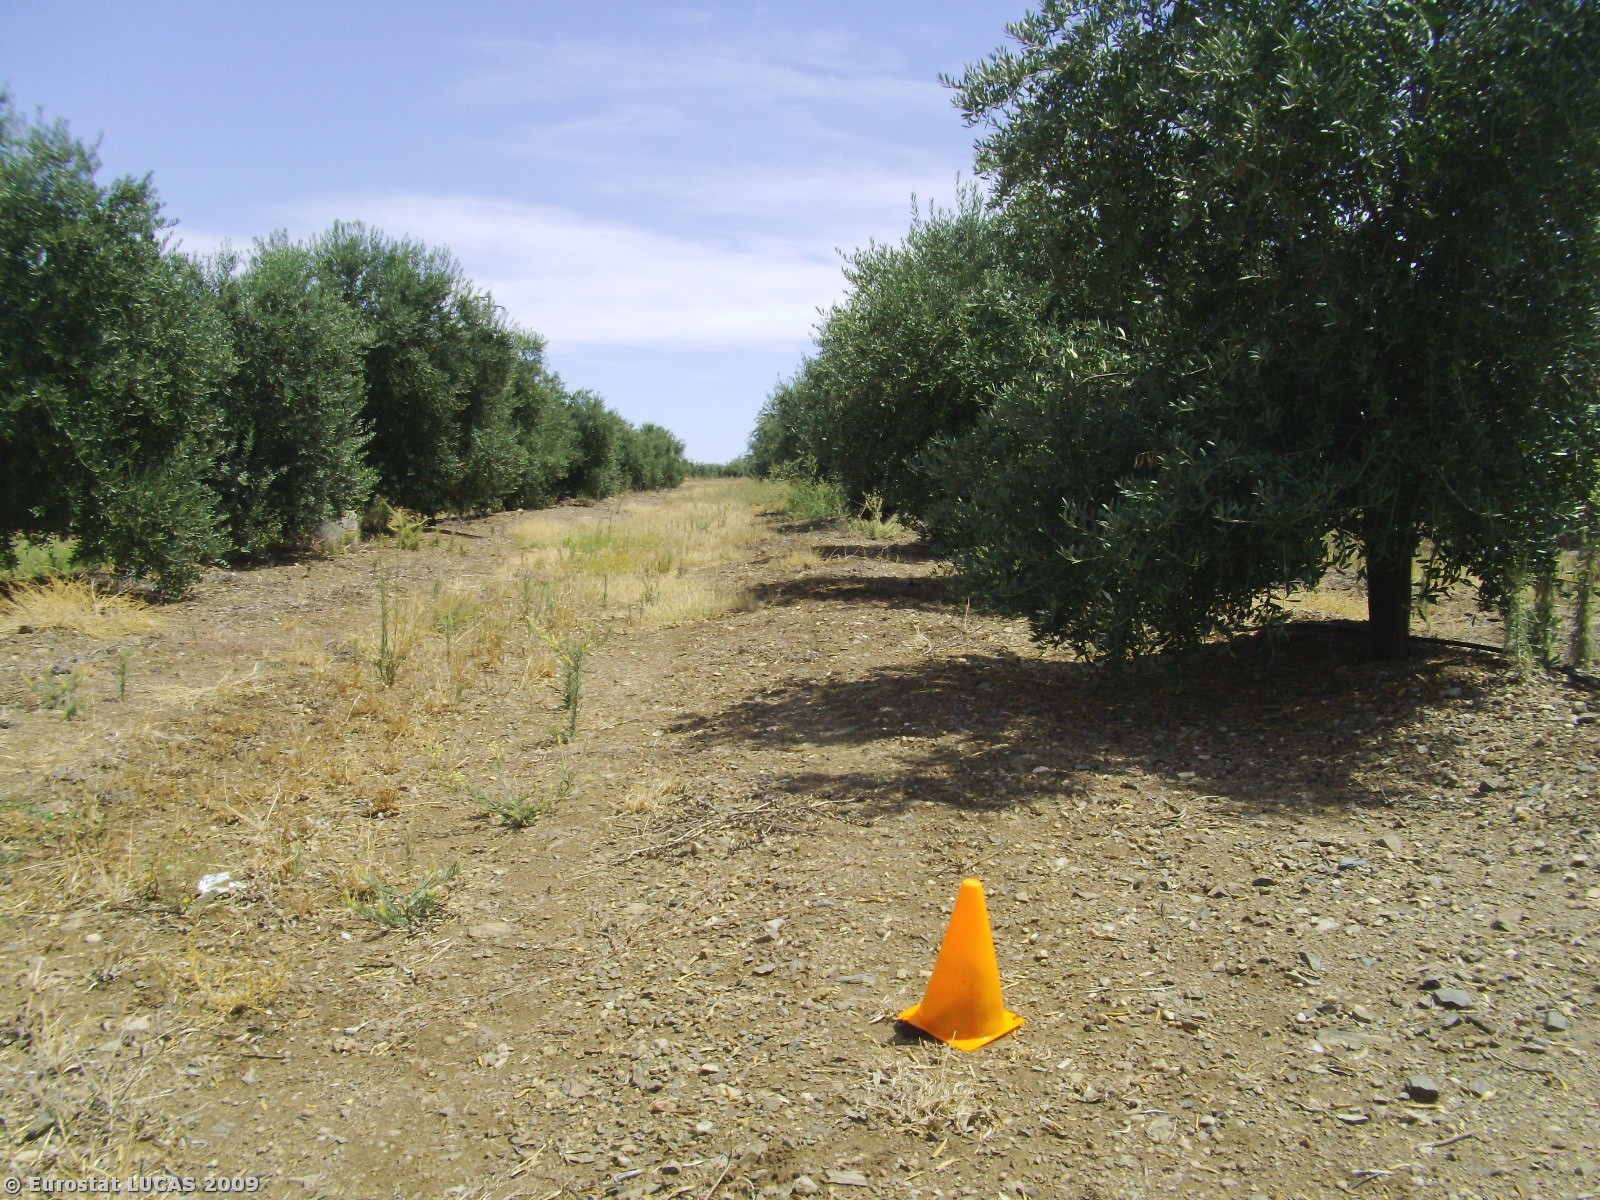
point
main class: Cropland
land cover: Olive groves
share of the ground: 50 - 75 %
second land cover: Bare land
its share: 25 - 50 %
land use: Agriculture (excluding fallow land and kitchen gardens)
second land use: Fallow land
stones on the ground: < 10 %
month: August
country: PT
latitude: 38.0832
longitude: -7.7315
